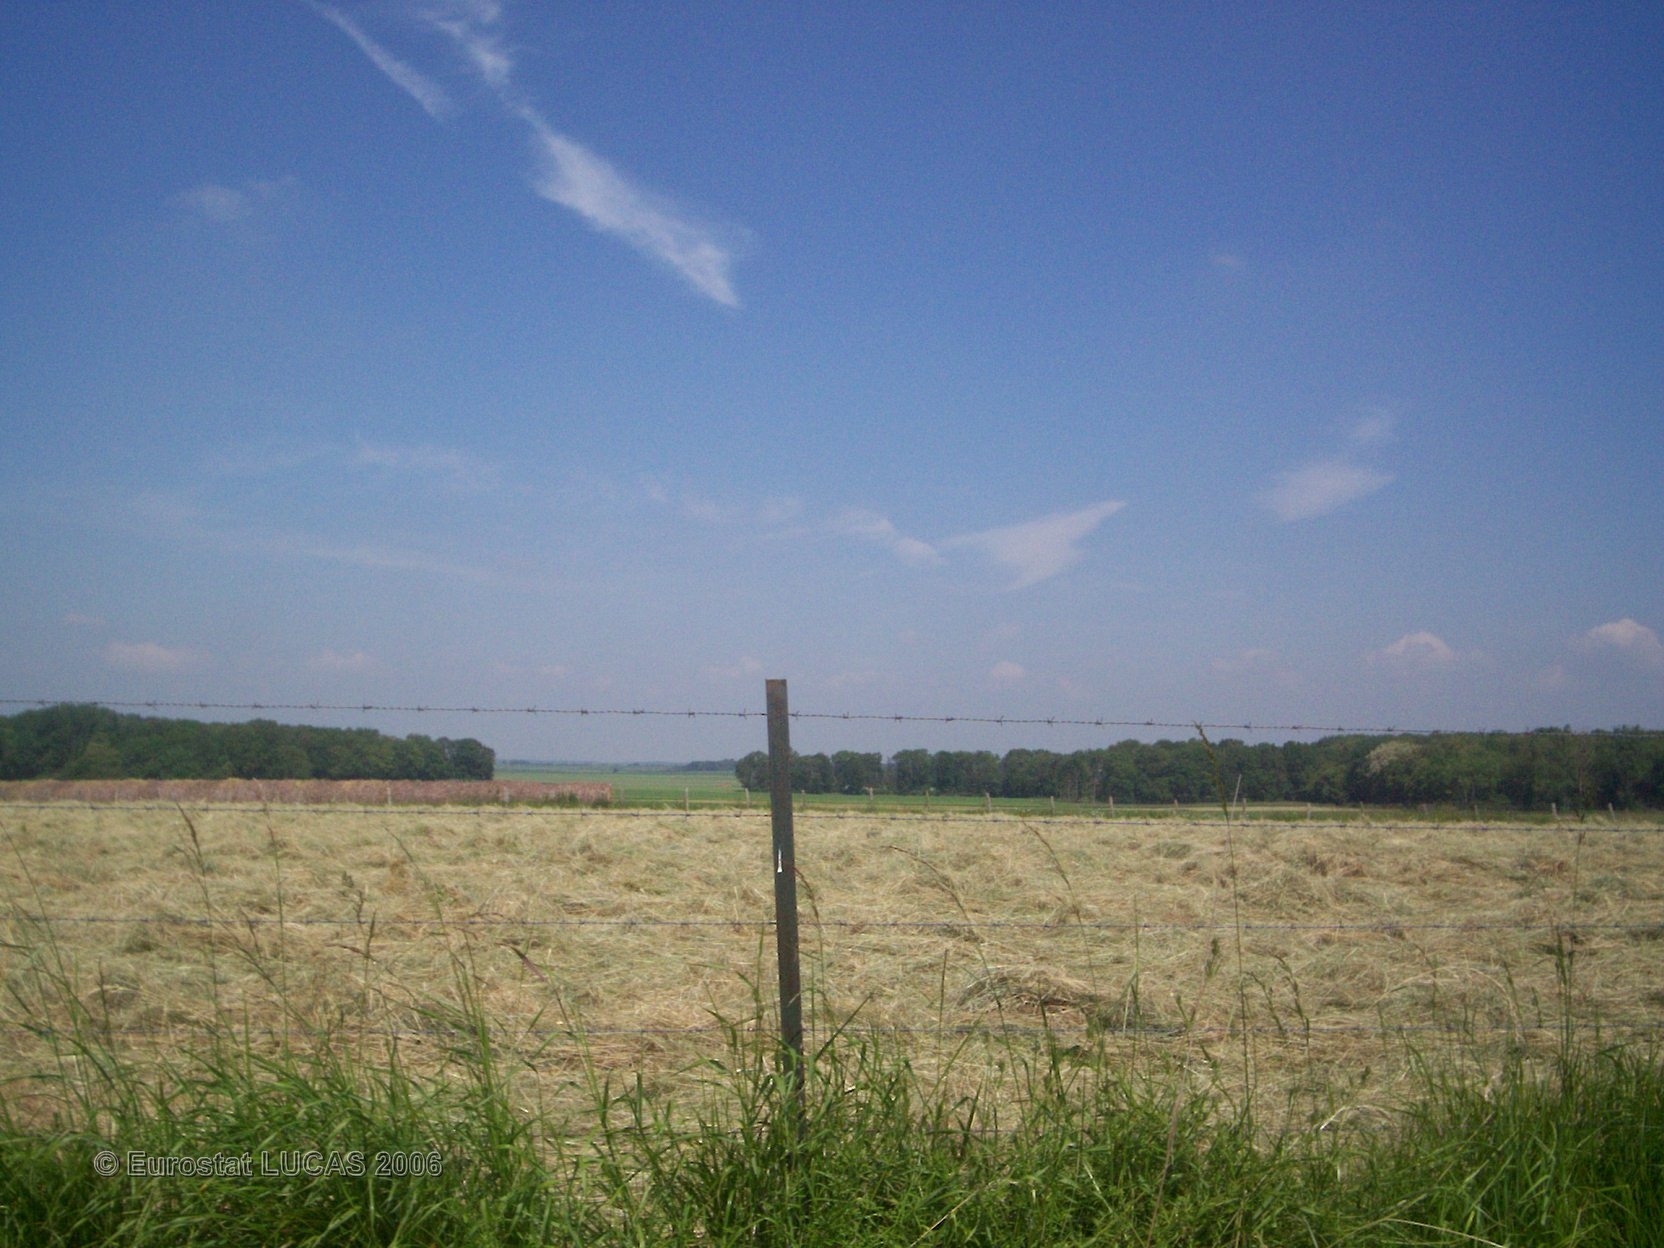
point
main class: Grassland
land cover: Grassland without tree/shrub cover
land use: Agriculture (excluding fallow land and kitchen gardens)
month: June
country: FR
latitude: 49.6247
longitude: 2.6935
